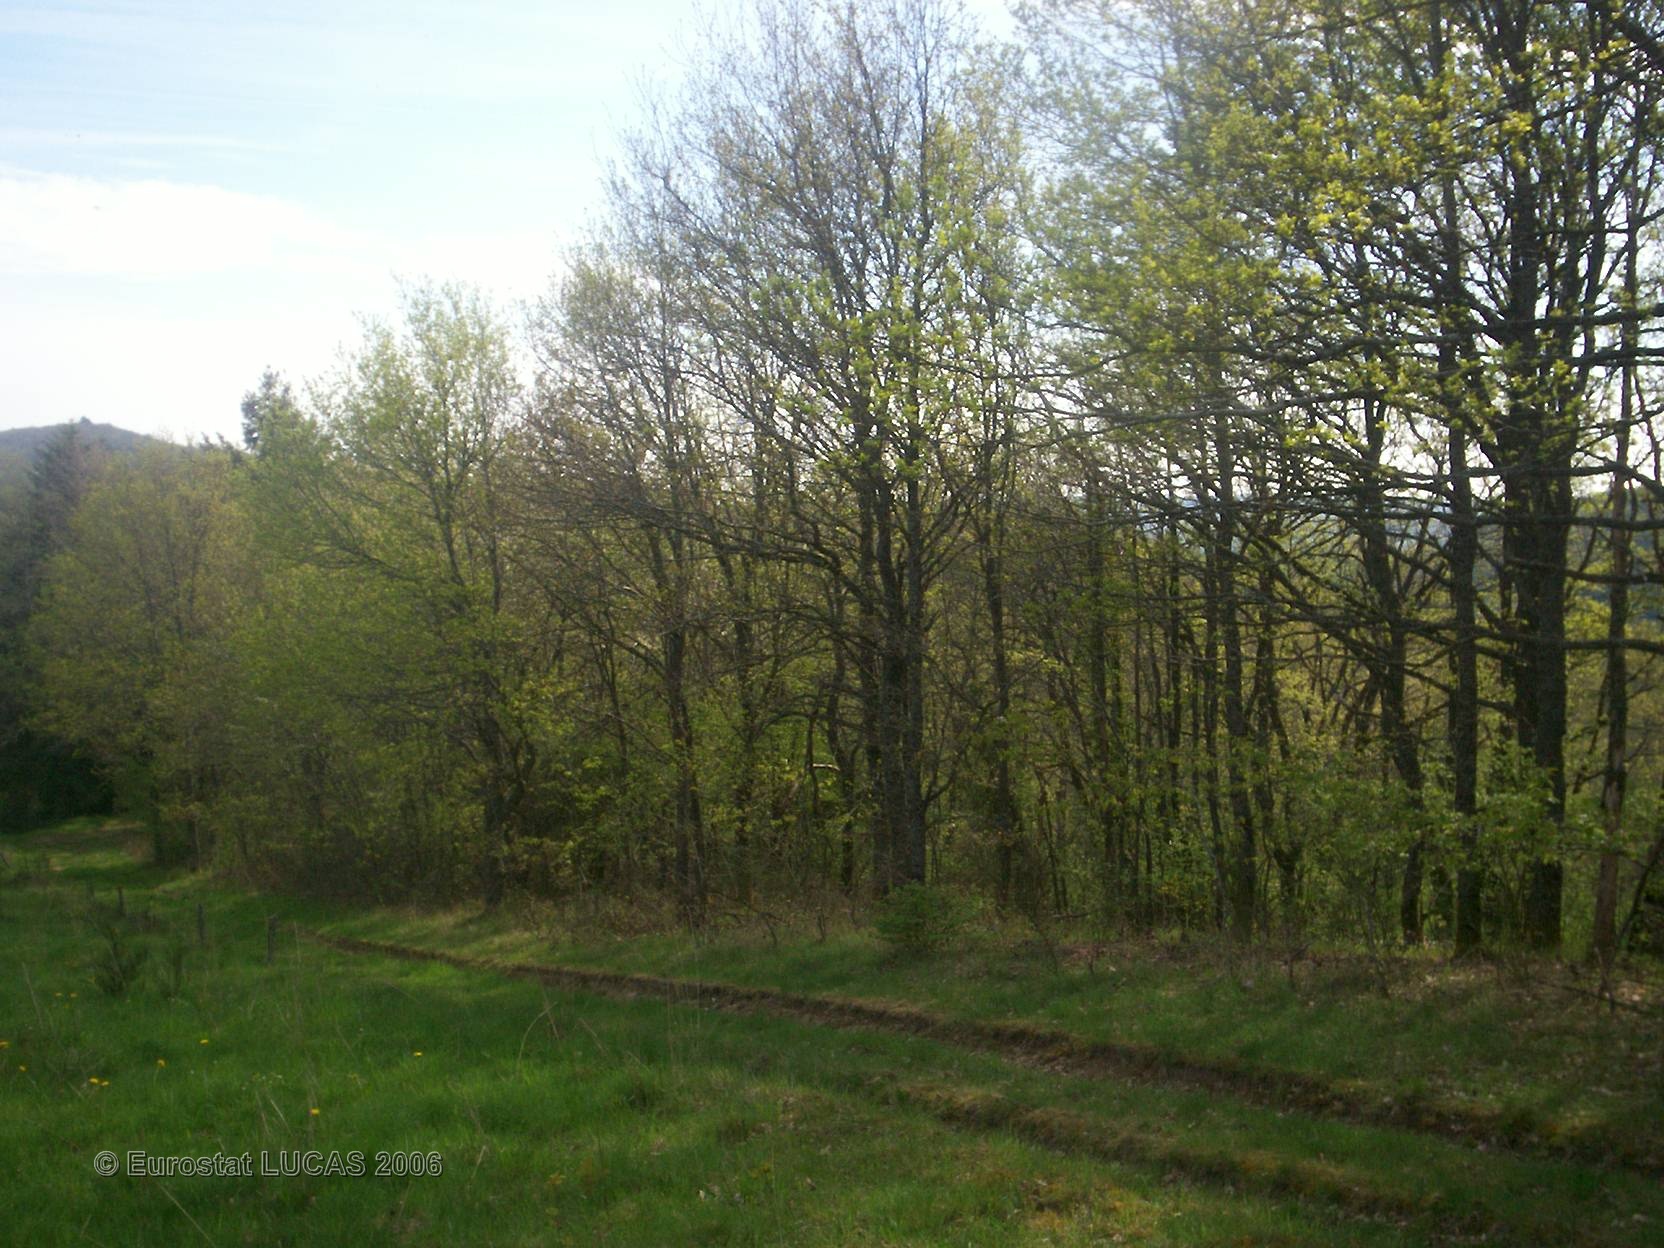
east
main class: Grassland
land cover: Grassland without tree/shrub cover
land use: Agriculture (excluding fallow land and kitchen gardens)
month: May
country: FR
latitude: 45.9714
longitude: 2.9132
